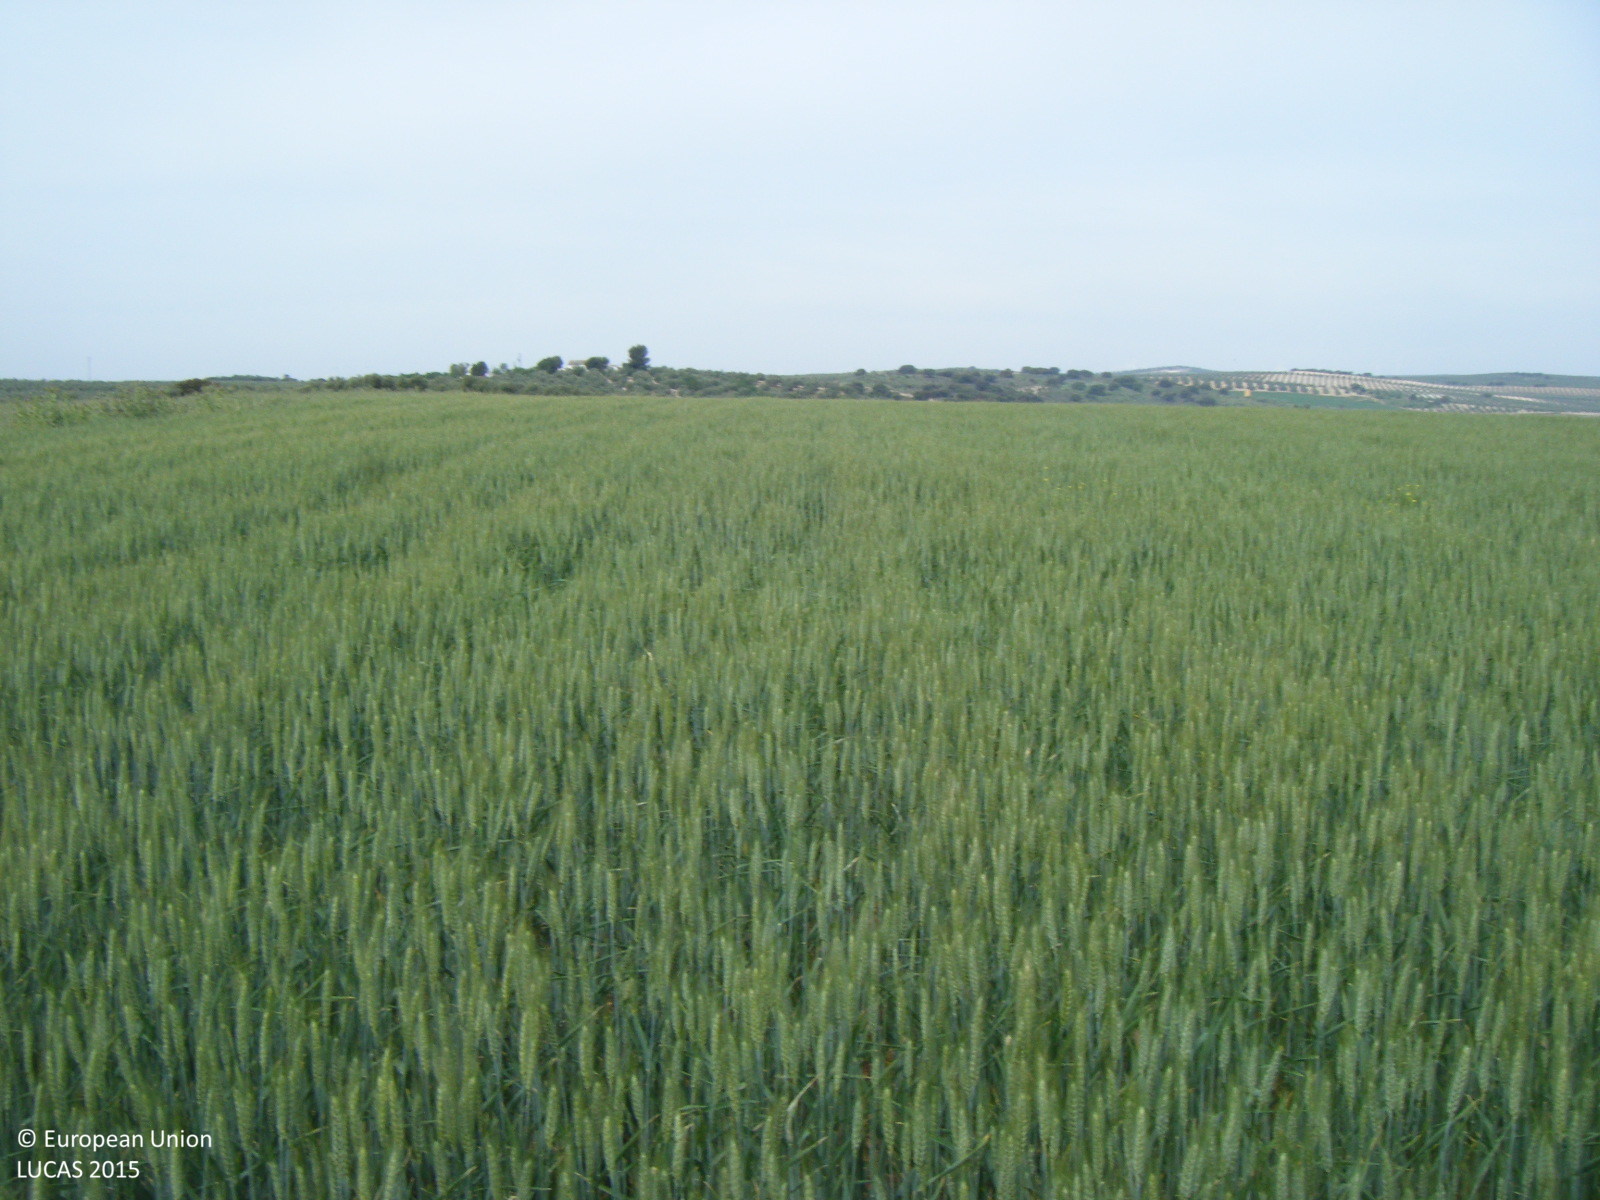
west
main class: Cropland
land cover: Durum wheat
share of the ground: > 75 %
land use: Agriculture (excluding fallow land and kitchen gardens)
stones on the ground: < 10 %
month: April
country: ES
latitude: 37.0840
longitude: -4.7709
